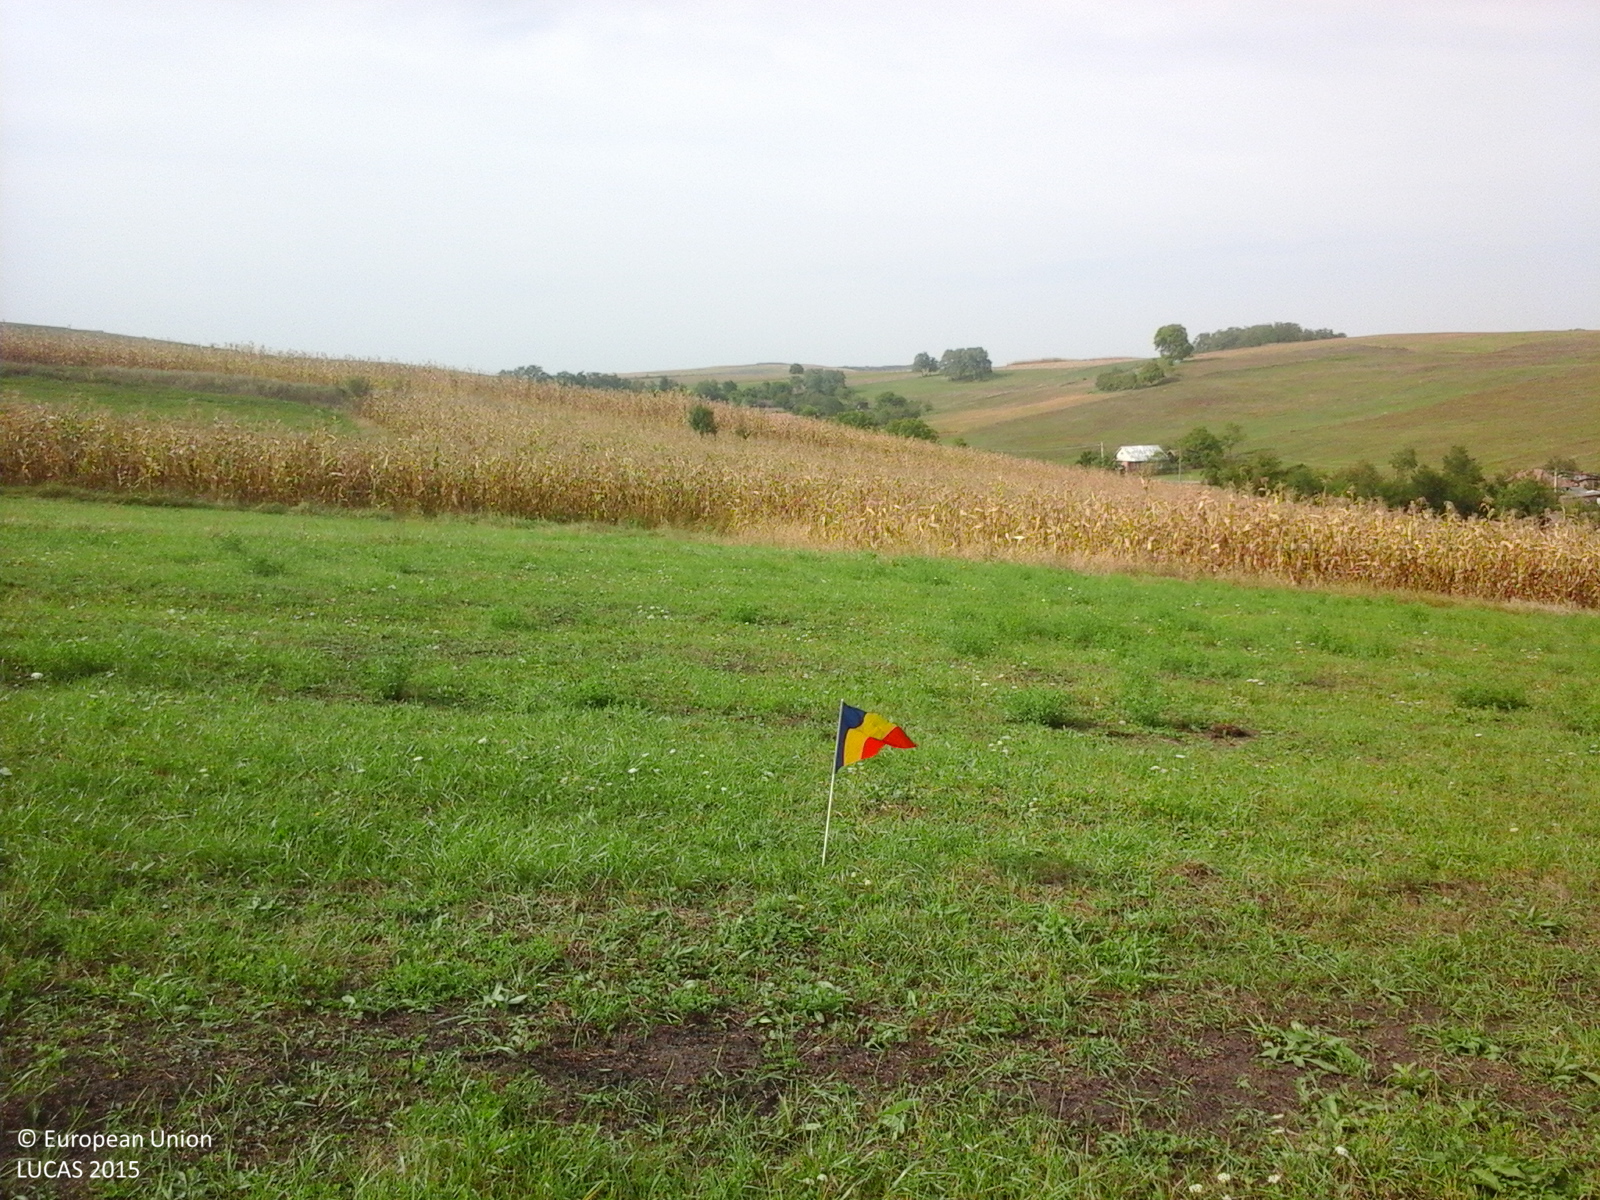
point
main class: Grassland
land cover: Grassland without tree/shrub cover
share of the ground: > 75 %
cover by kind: herbaceous plants 100 %
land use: Agriculture (excluding fallow land and kitchen gardens)
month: September
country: RO
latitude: 46.8375
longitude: 24.2309
